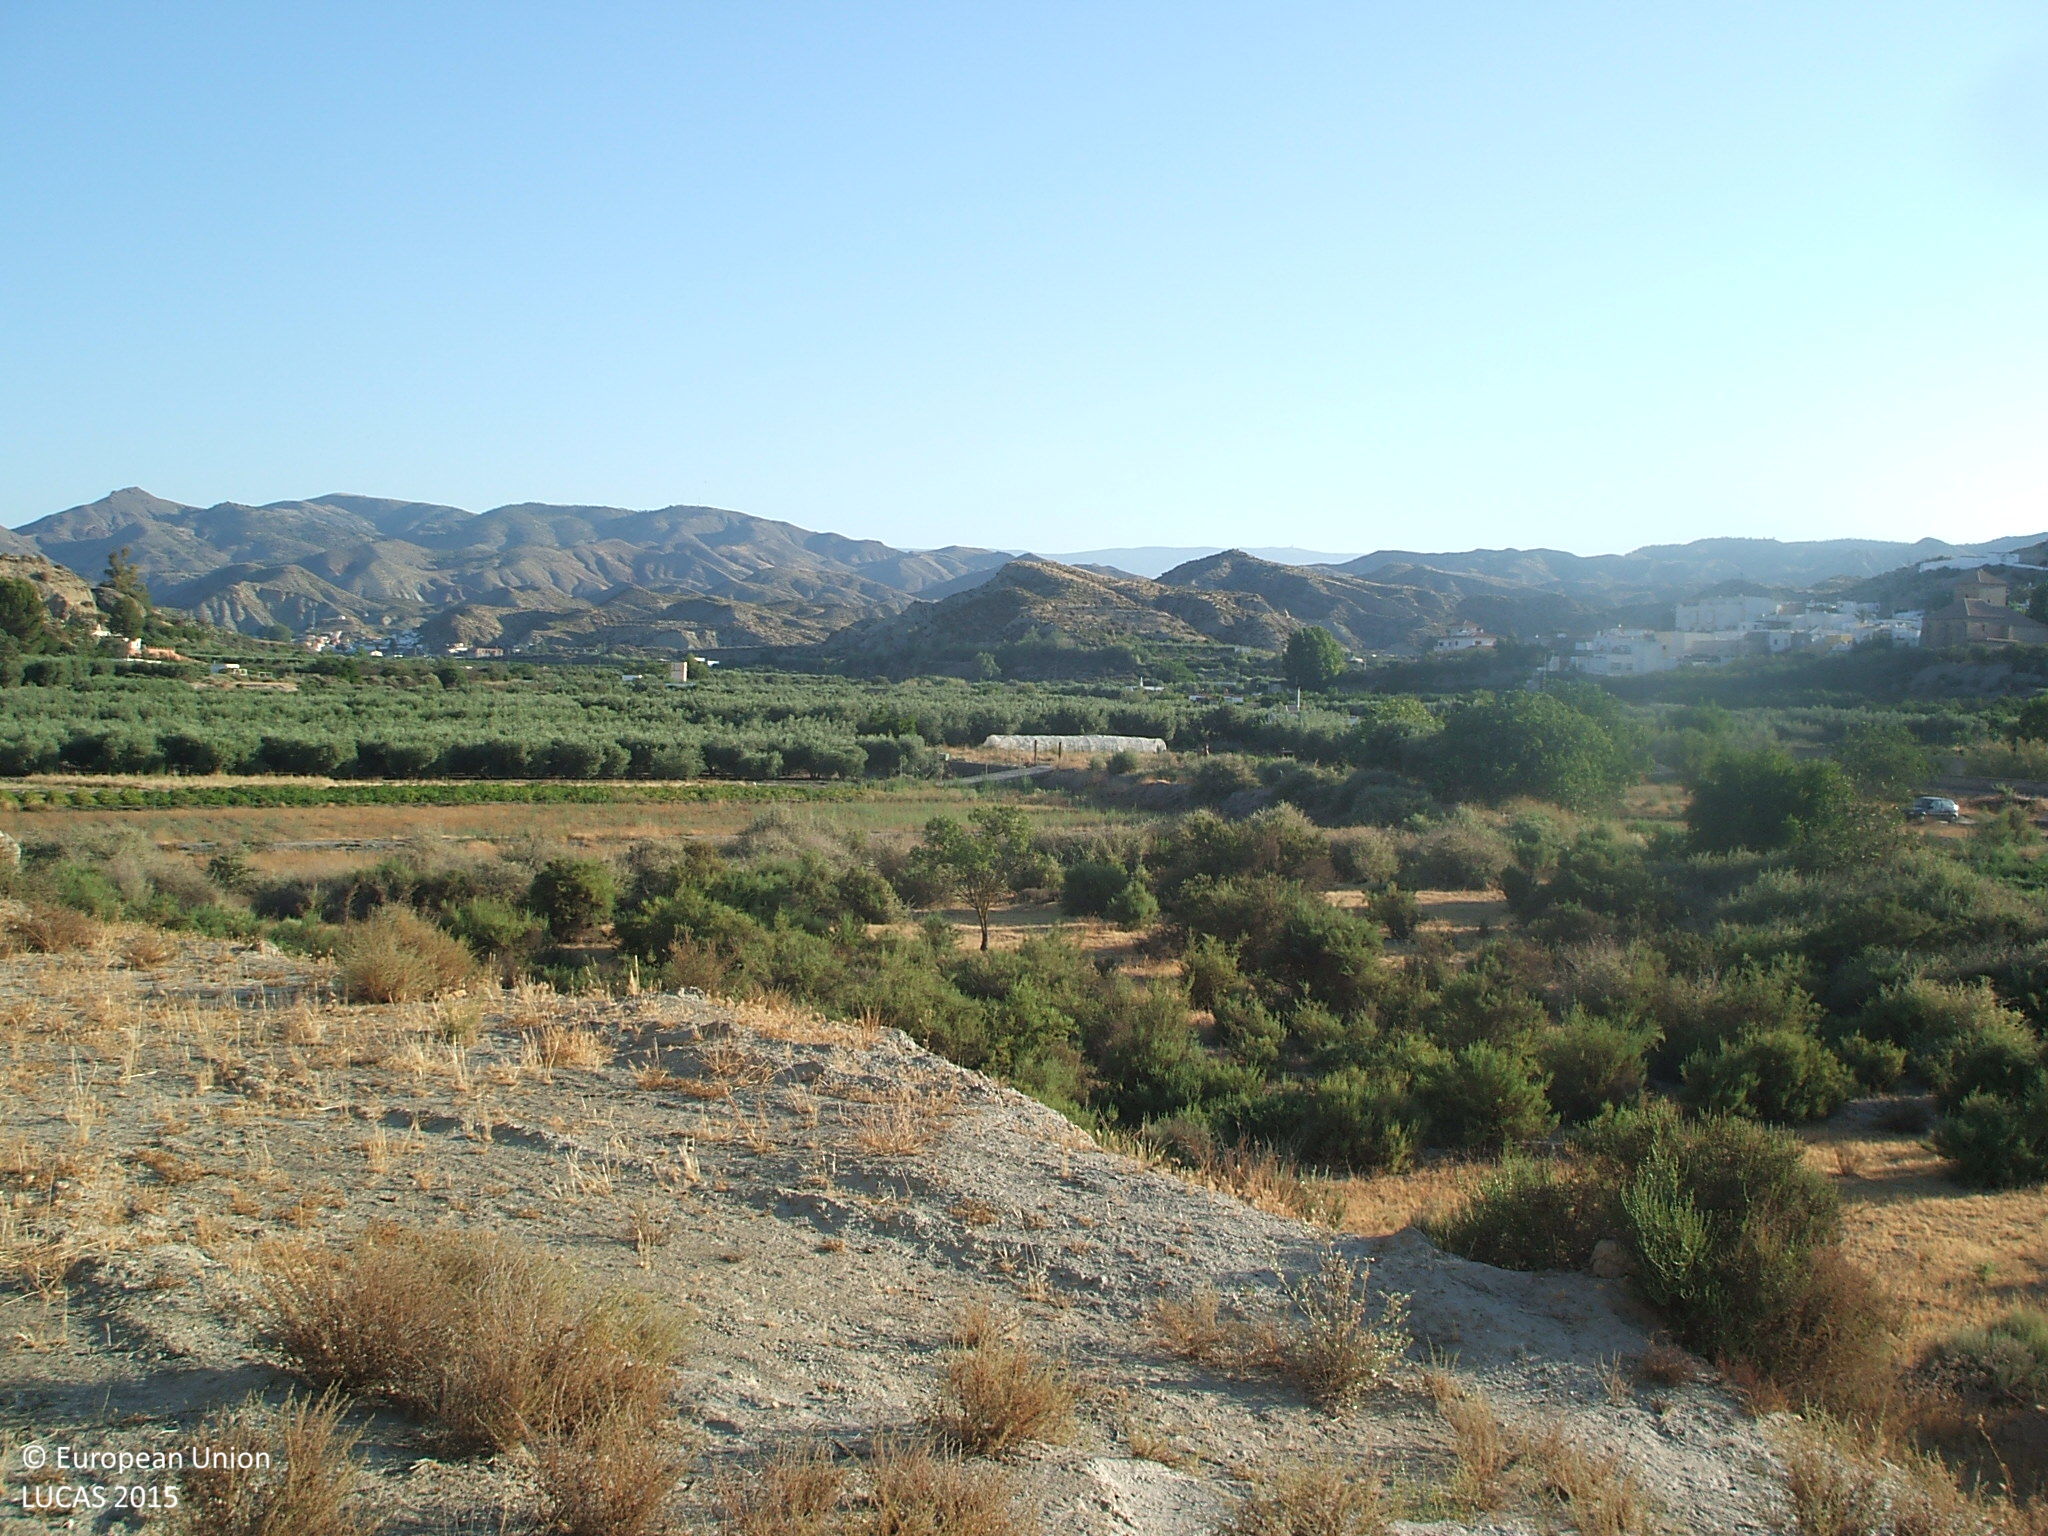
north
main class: Shrubland
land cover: Shrubland without tree cover
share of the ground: 50 - 75 %
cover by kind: shrubs 60 %, consolidated bare surface 40 %
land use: Semi-natural and natural areas not in use
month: June
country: ES
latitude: 36.9979
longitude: -2.5972
